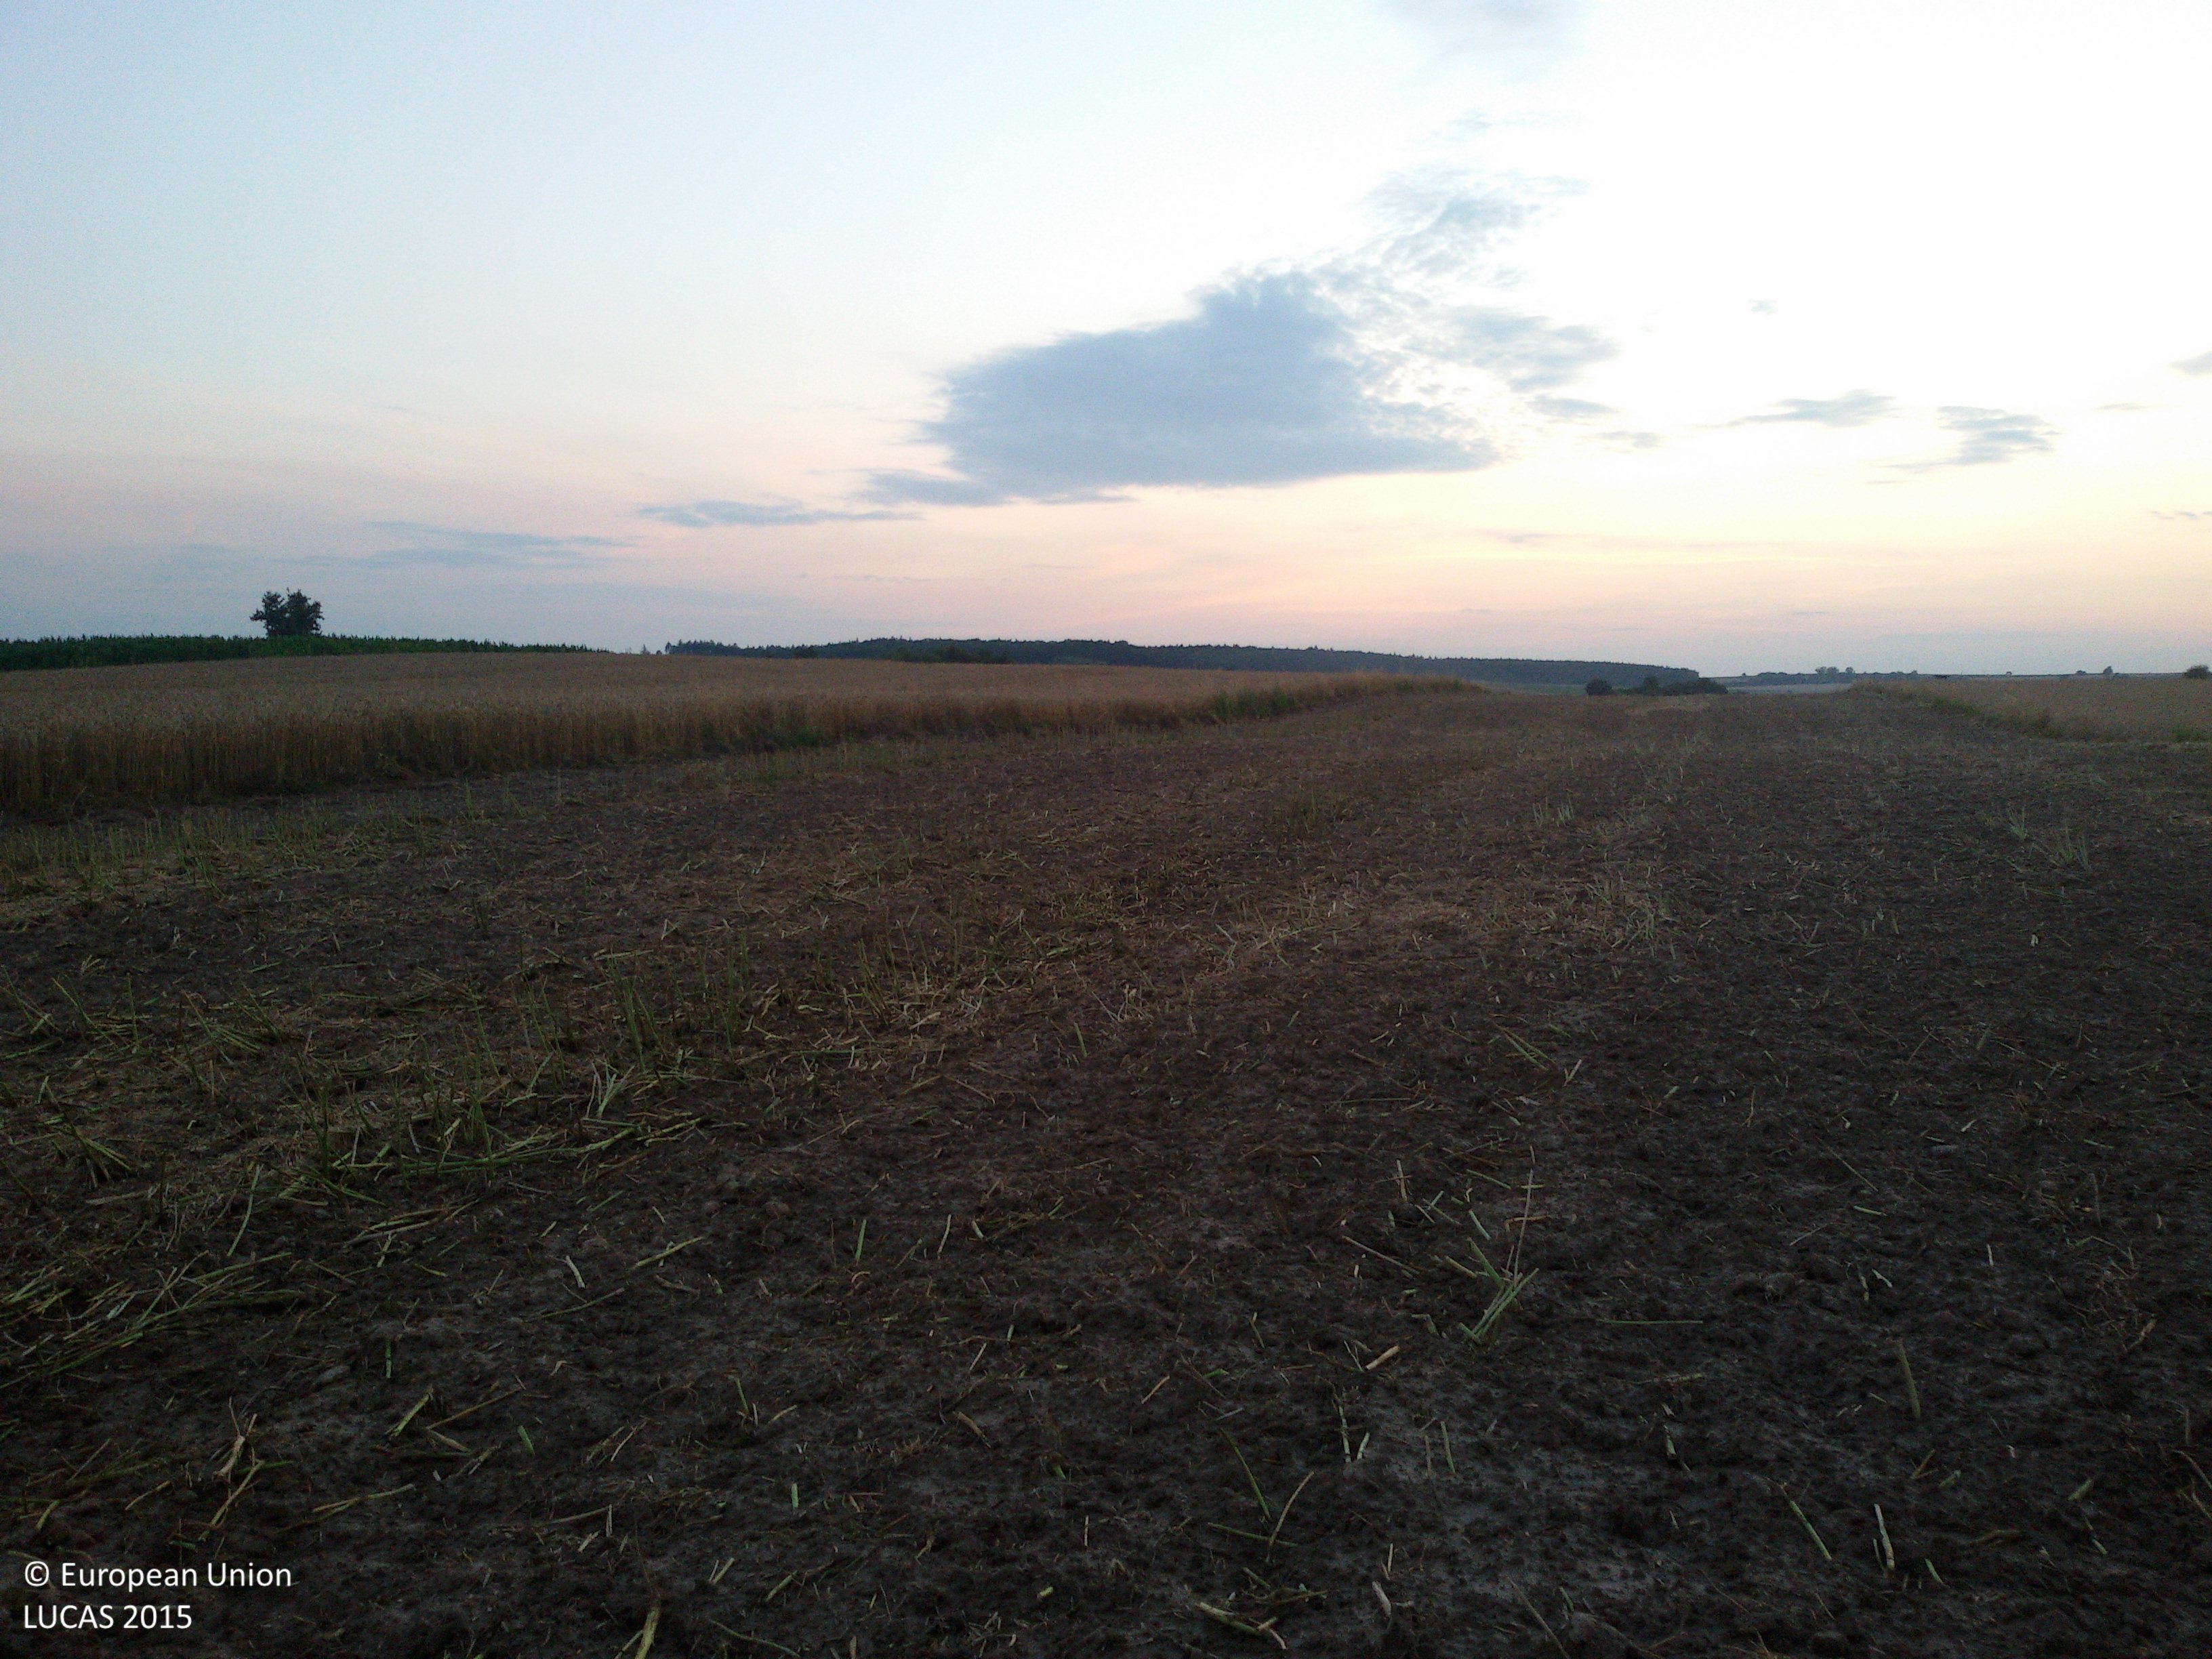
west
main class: Cropland
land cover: Rape and turnip rape
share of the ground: < 10 %
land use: Agriculture (excluding fallow land and kitchen gardens)
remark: Harvested field
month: July
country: PL
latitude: 50.9543
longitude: 23.4215
